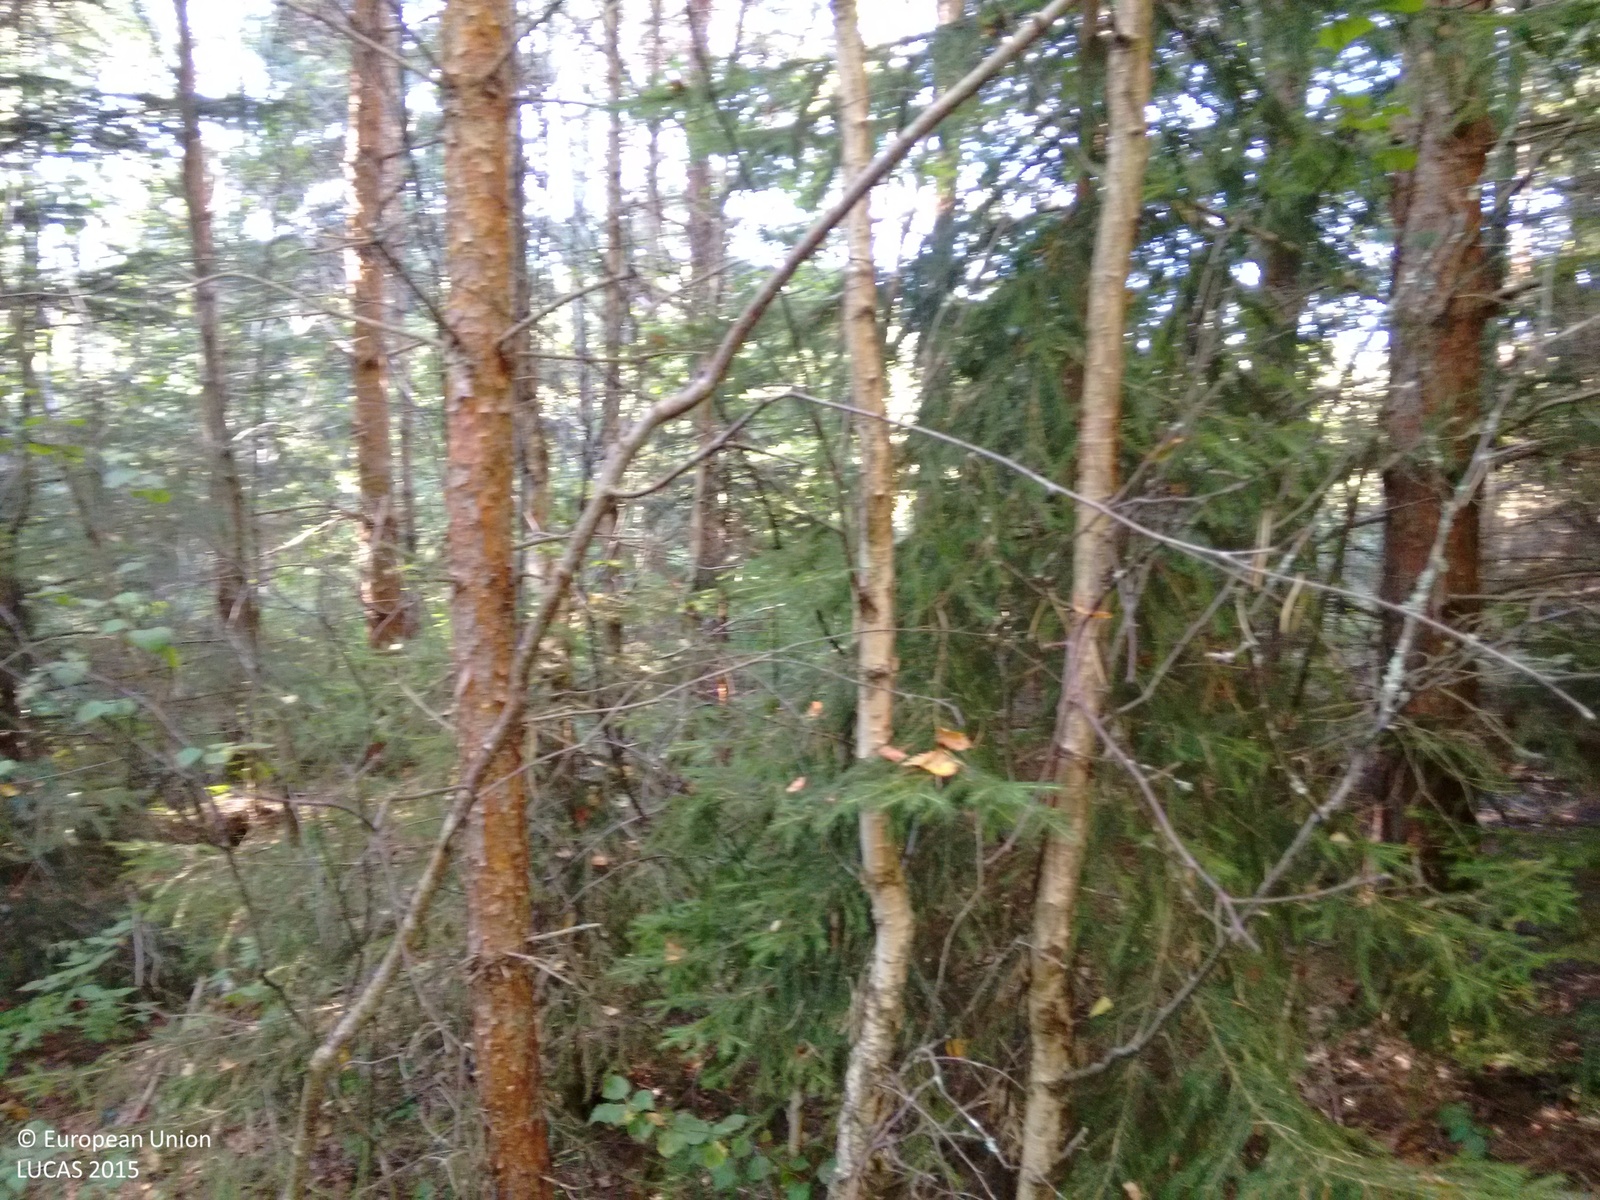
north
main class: Woodland
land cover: Pine dominated mixed woodland
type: hemiboreal forest and nemoral coniferous forest and mixed broadleaved-coniferous forest
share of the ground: > 75 %
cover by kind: coniferous forest trees 55 %, broadleaved forest trees 30 %, herbaceous plants 15 %
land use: Forestry
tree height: > 5 m
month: August
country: FI
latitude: 60.1632
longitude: 19.5717
